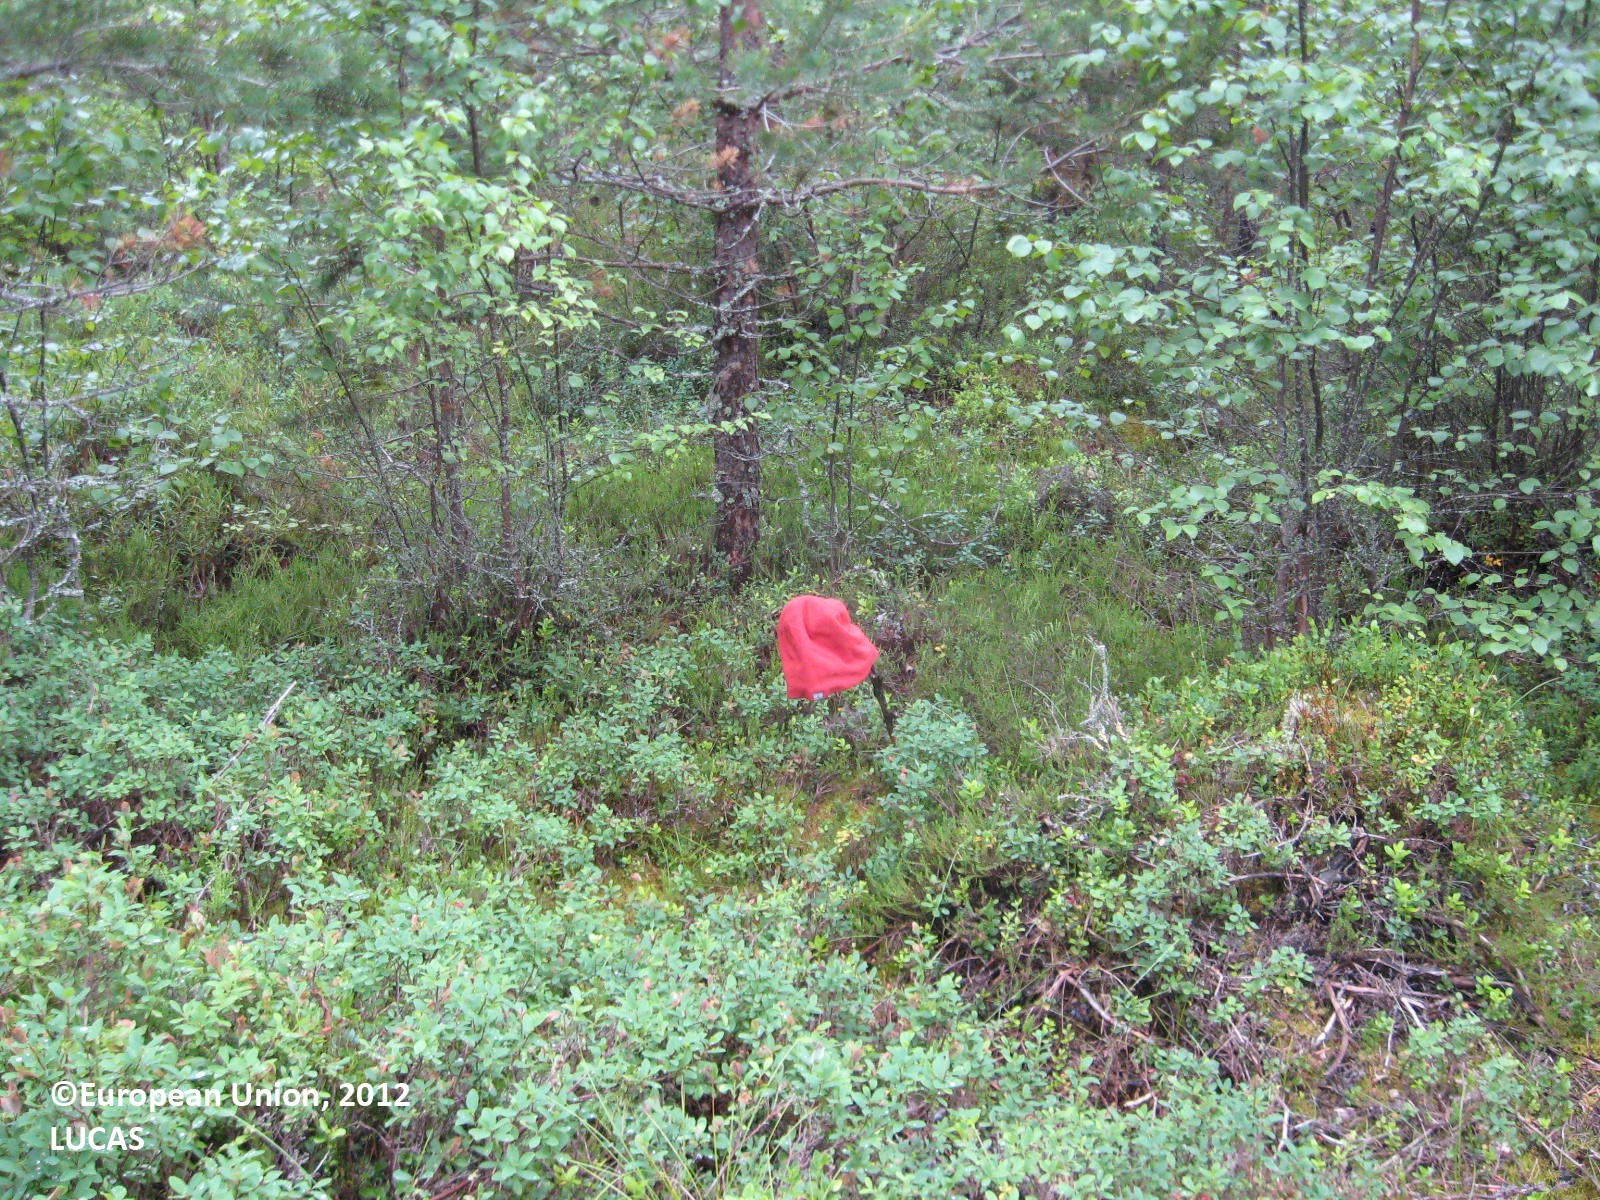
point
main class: Woodland
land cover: Pine dominated coniferous woodland
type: boreal forest
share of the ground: > 75 %
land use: Forestry
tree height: < 5 m
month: July
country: FI
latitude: 62.3763
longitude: 22.5658
